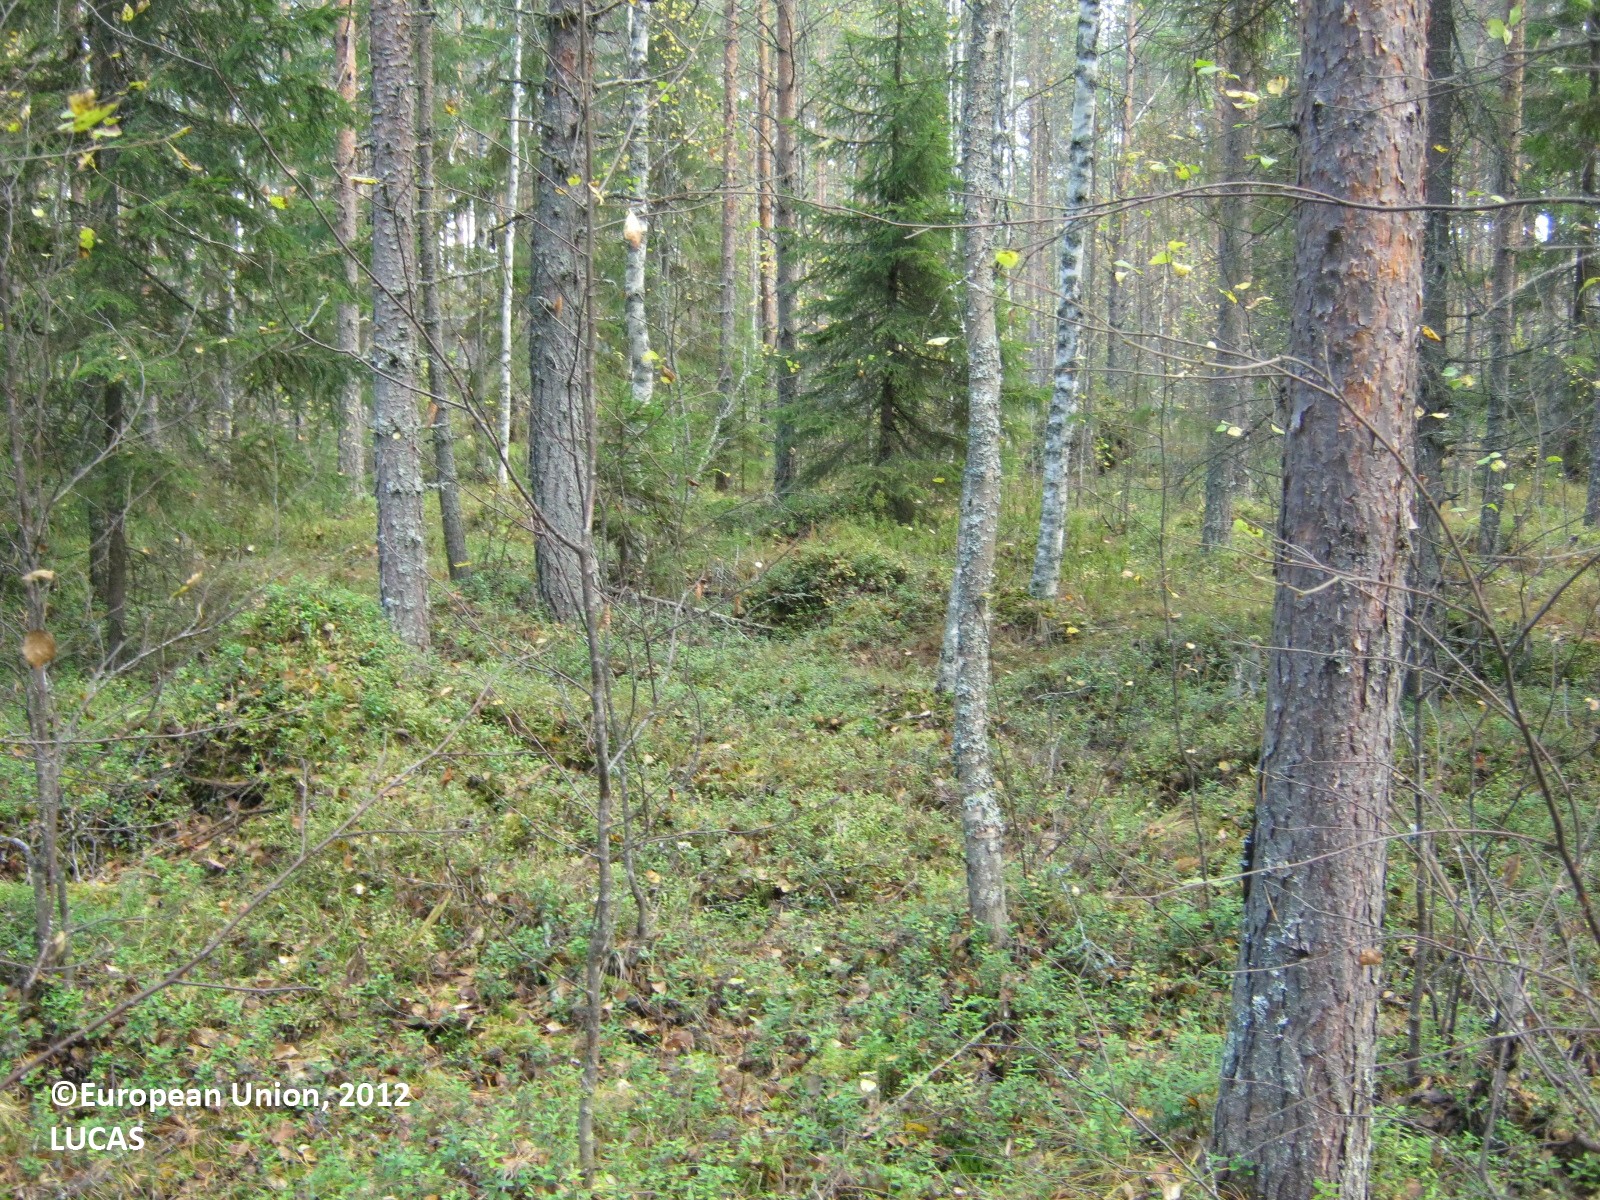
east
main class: Woodland
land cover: Pine dominated coniferous woodland
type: boreal forest
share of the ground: > 75 %
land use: Forestry
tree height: > 5 m
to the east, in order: Pine dominated coniferous woodland; Ditches and canals; Pine dominated mixed woodland; Pine dominated coniferous woodland
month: September
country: FI
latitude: 63.3545
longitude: 25.8404
